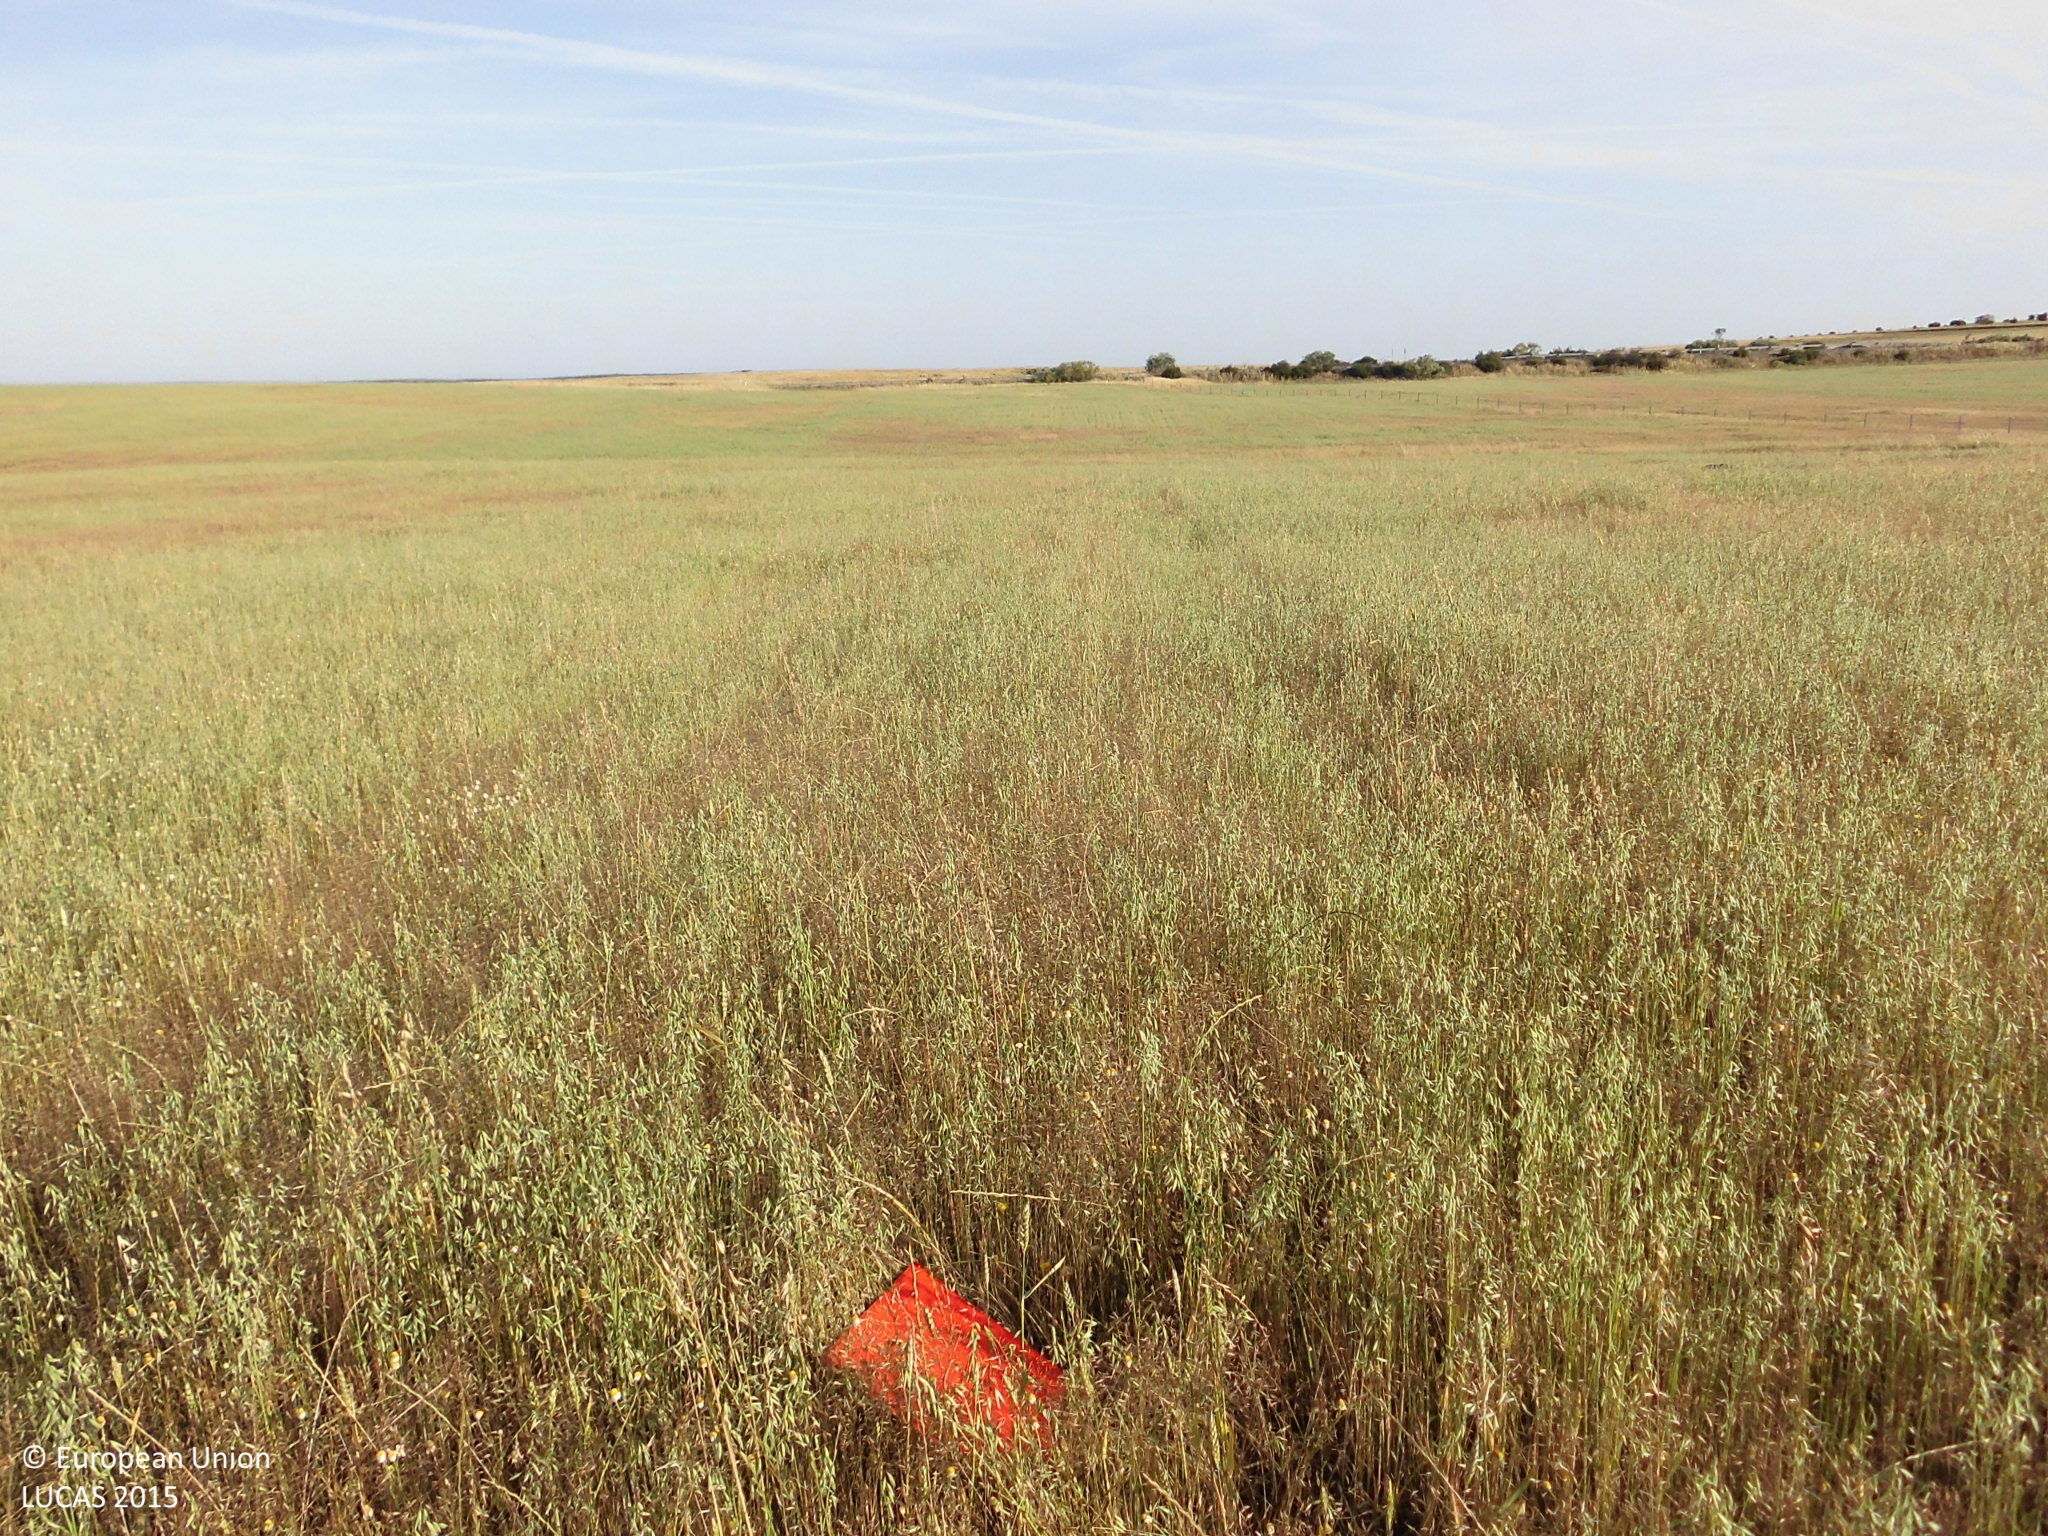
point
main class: Cropland
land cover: Oats
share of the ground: > 75 %
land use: Agriculture (excluding fallow land and kitchen gardens)
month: May
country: ES
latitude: 39.6084
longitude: -6.9593
